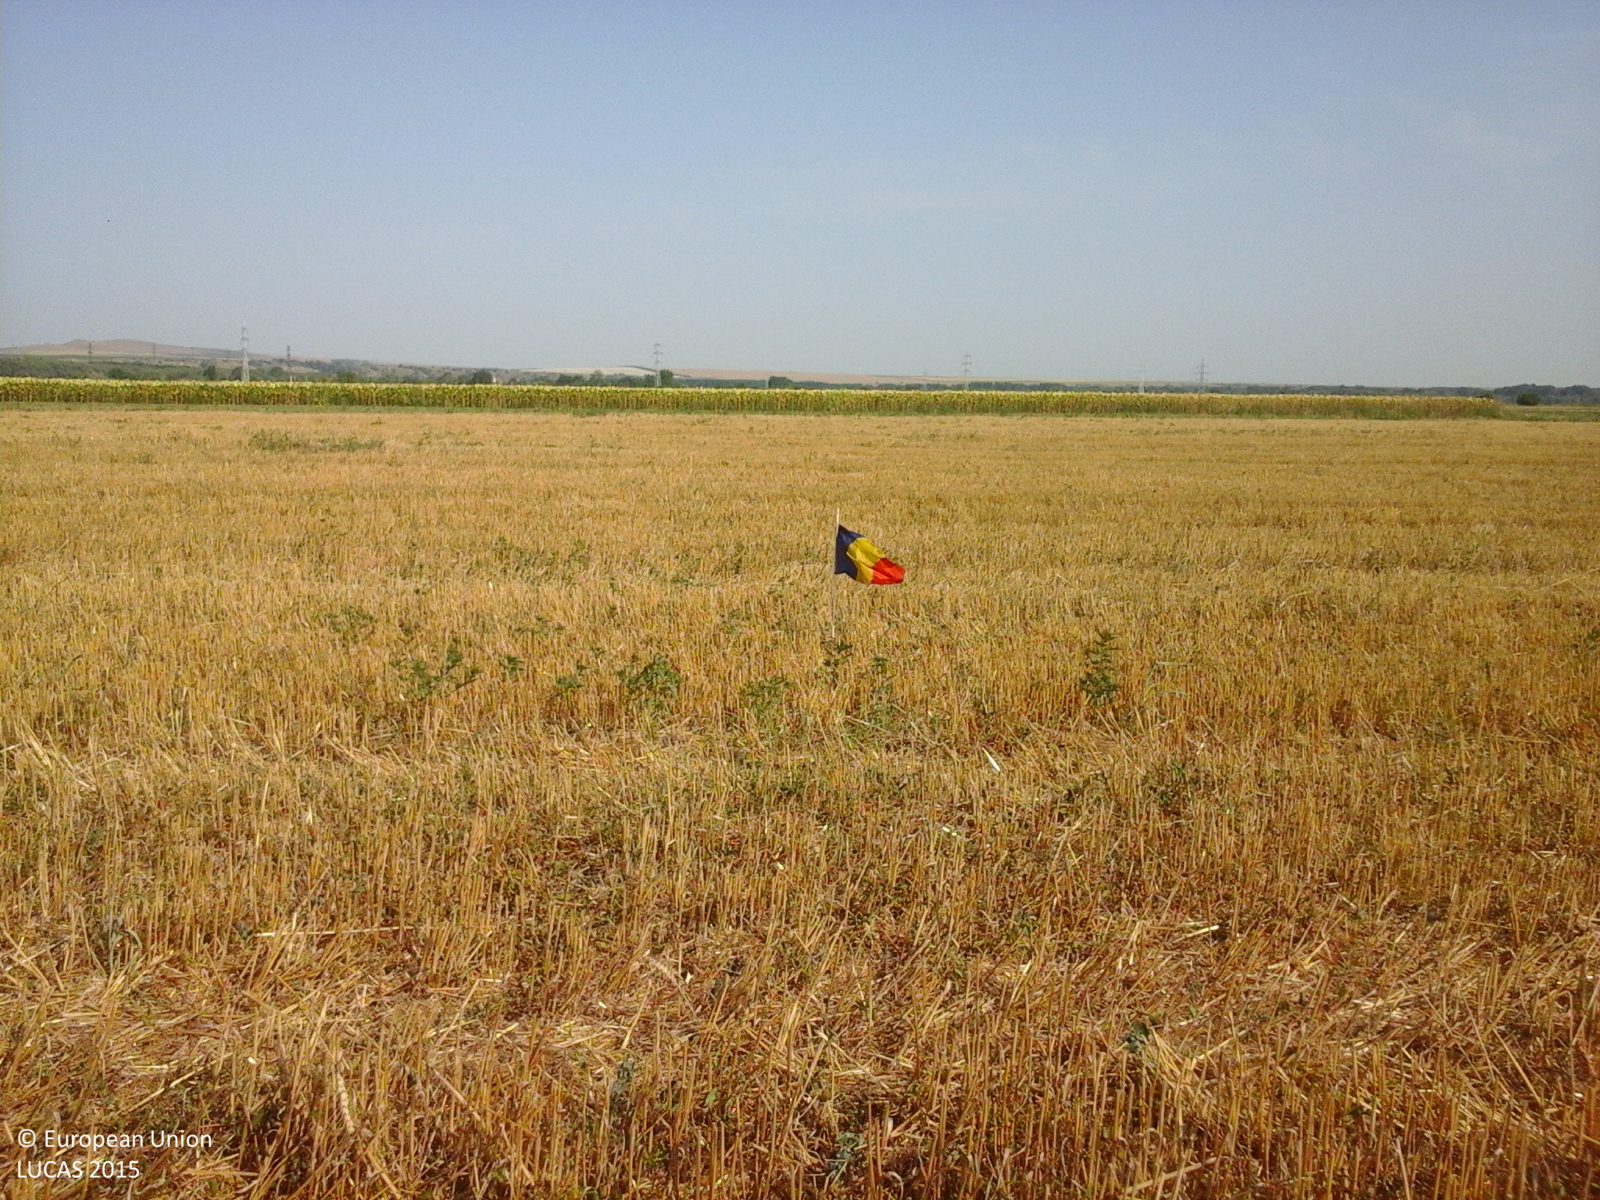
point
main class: Cropland
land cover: Common wheat
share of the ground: 25 - 50 %
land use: Agriculture (excluding fallow land and kitchen gardens)
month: August
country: RO
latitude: 44.8991
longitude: 28.1103
